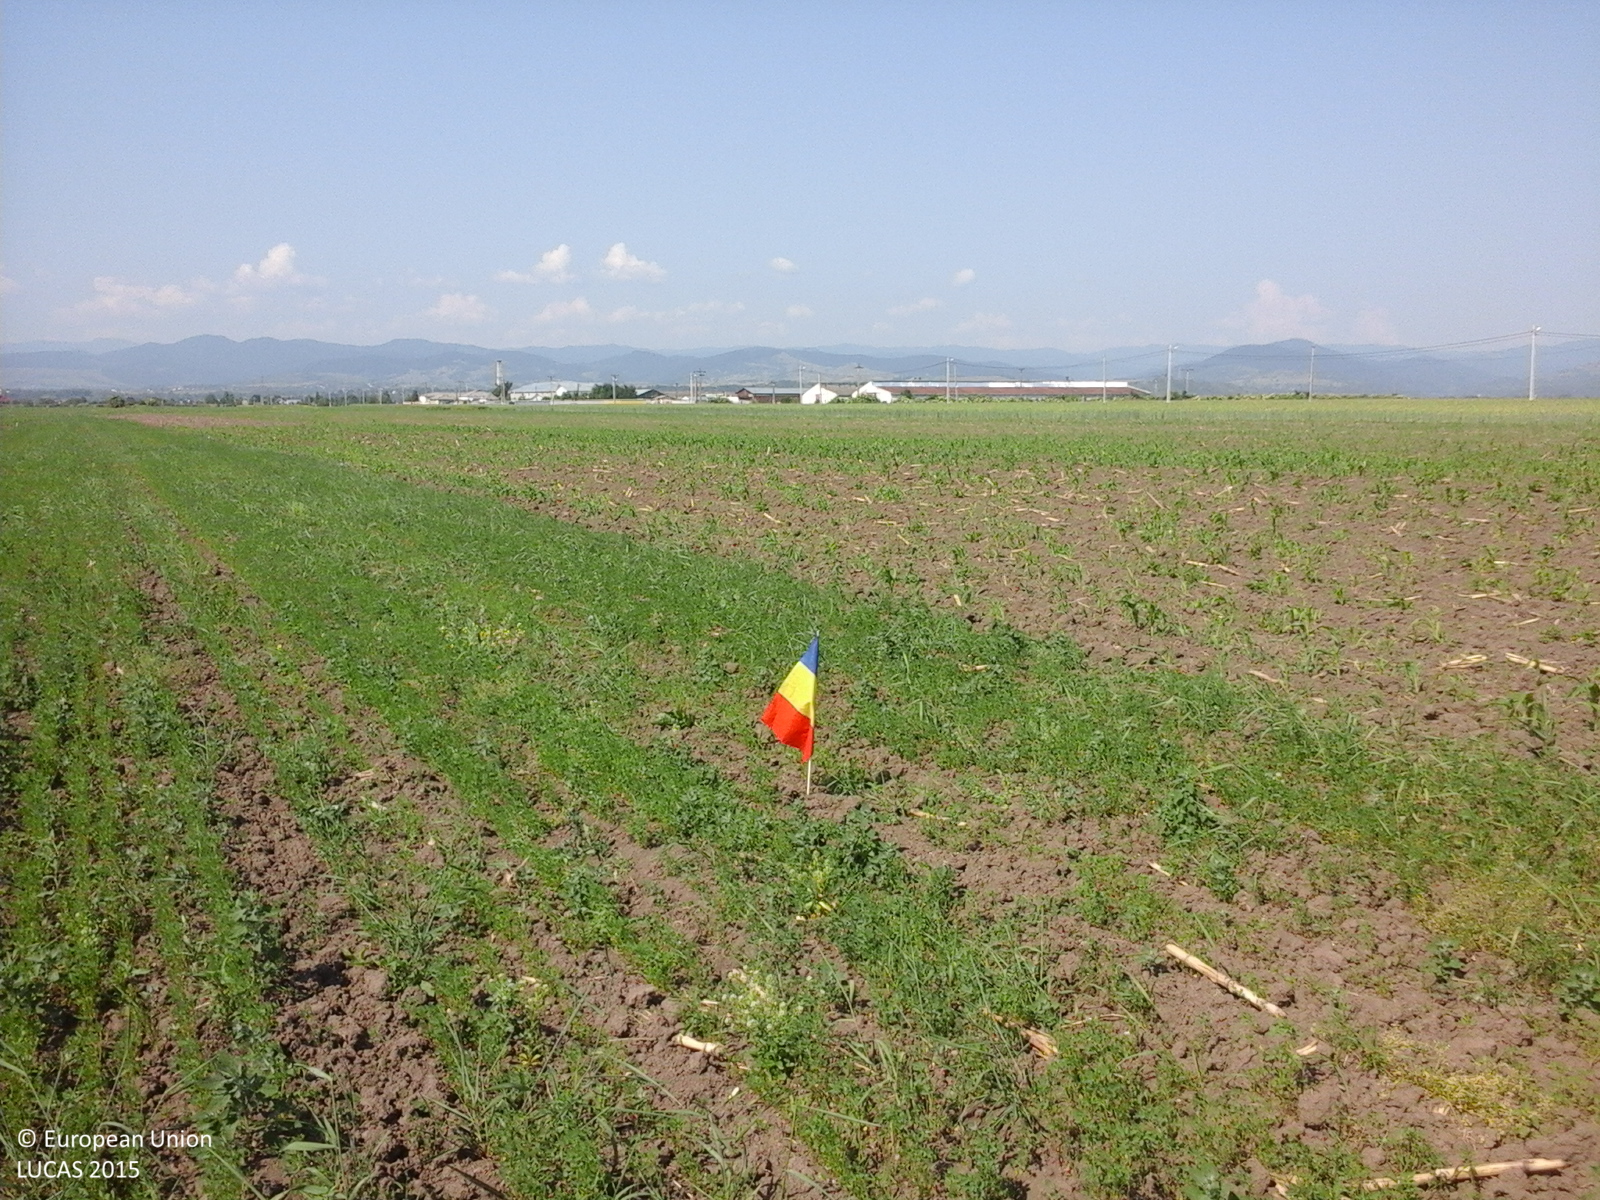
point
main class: Cropland
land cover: Lucerne
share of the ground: > 75 %
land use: Agriculture (excluding fallow land and kitchen gardens)
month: June
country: RO
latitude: 46.8301
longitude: 26.5650
